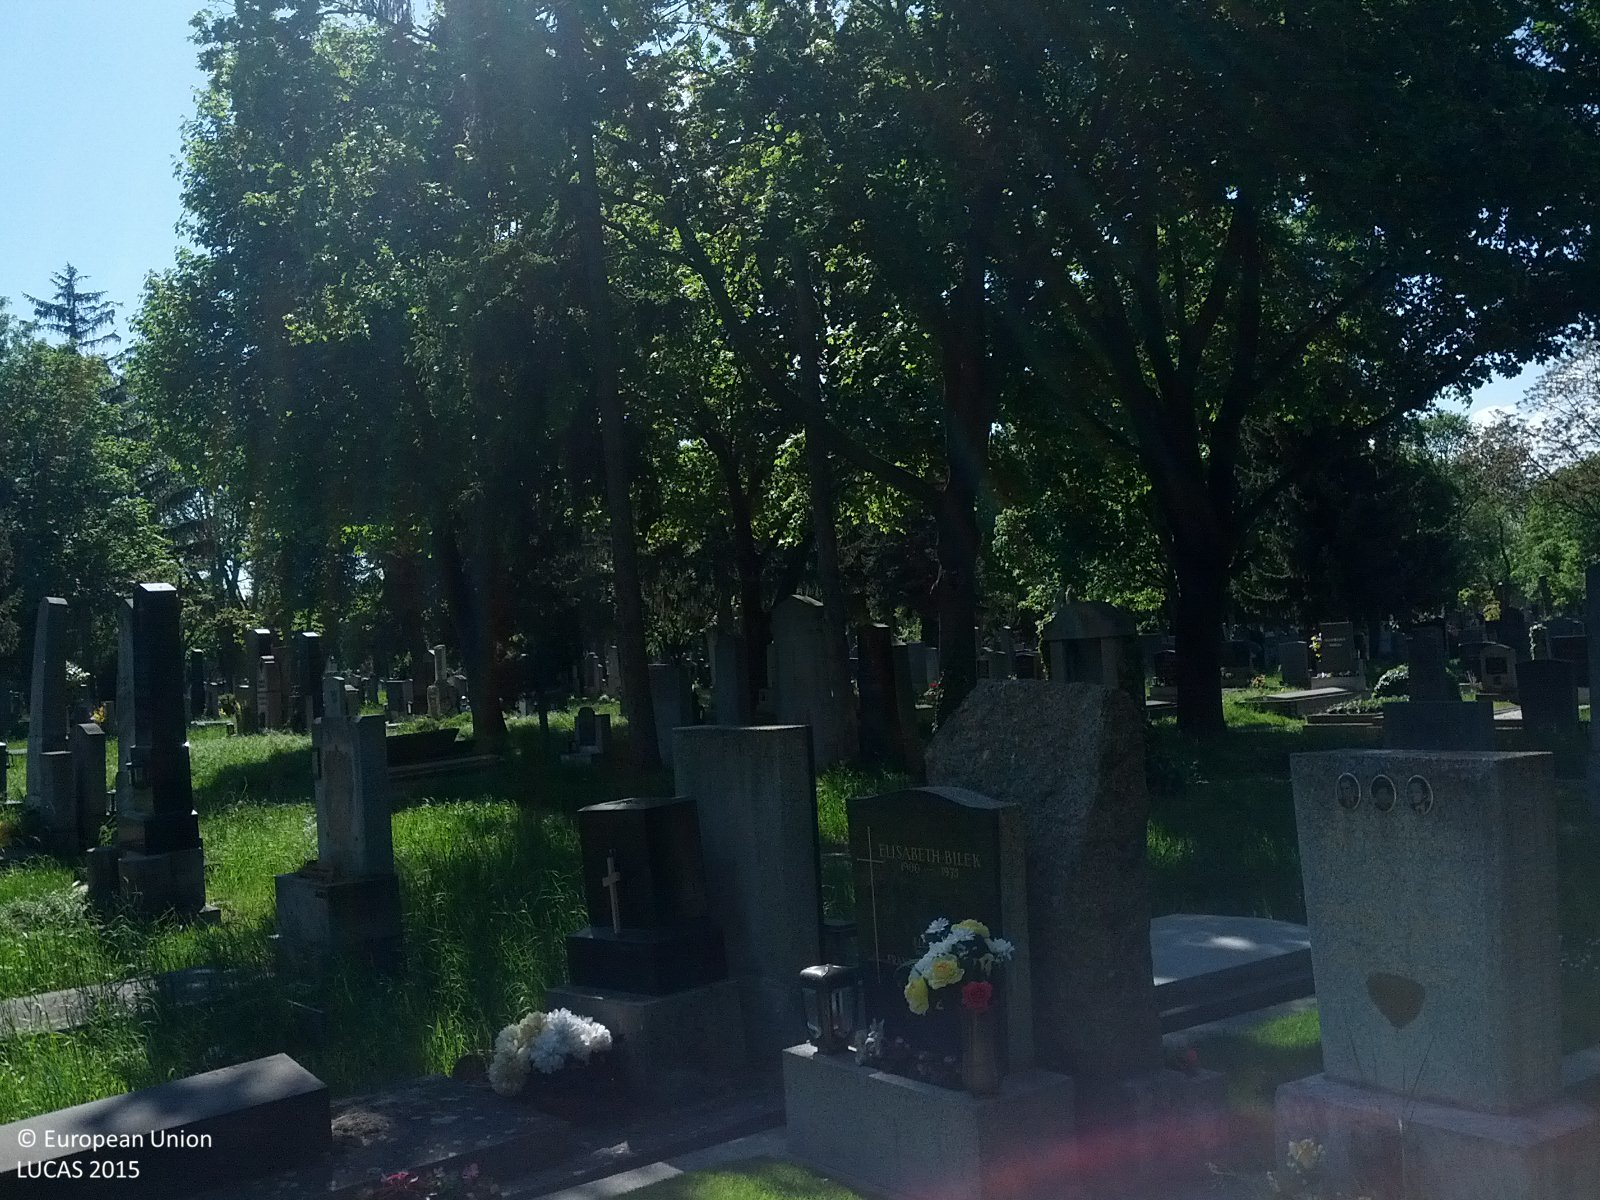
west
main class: Woodland
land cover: Broadleaved woodland
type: mesophytic deciduous forest
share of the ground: < 10 %
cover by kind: herbaceous plants 70 %, broadleaved forest trees 15 %, consolidated bare surface 15 %
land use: Community services
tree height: > 5 m
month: May
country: AT
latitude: 48.1434
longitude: 16.4428
